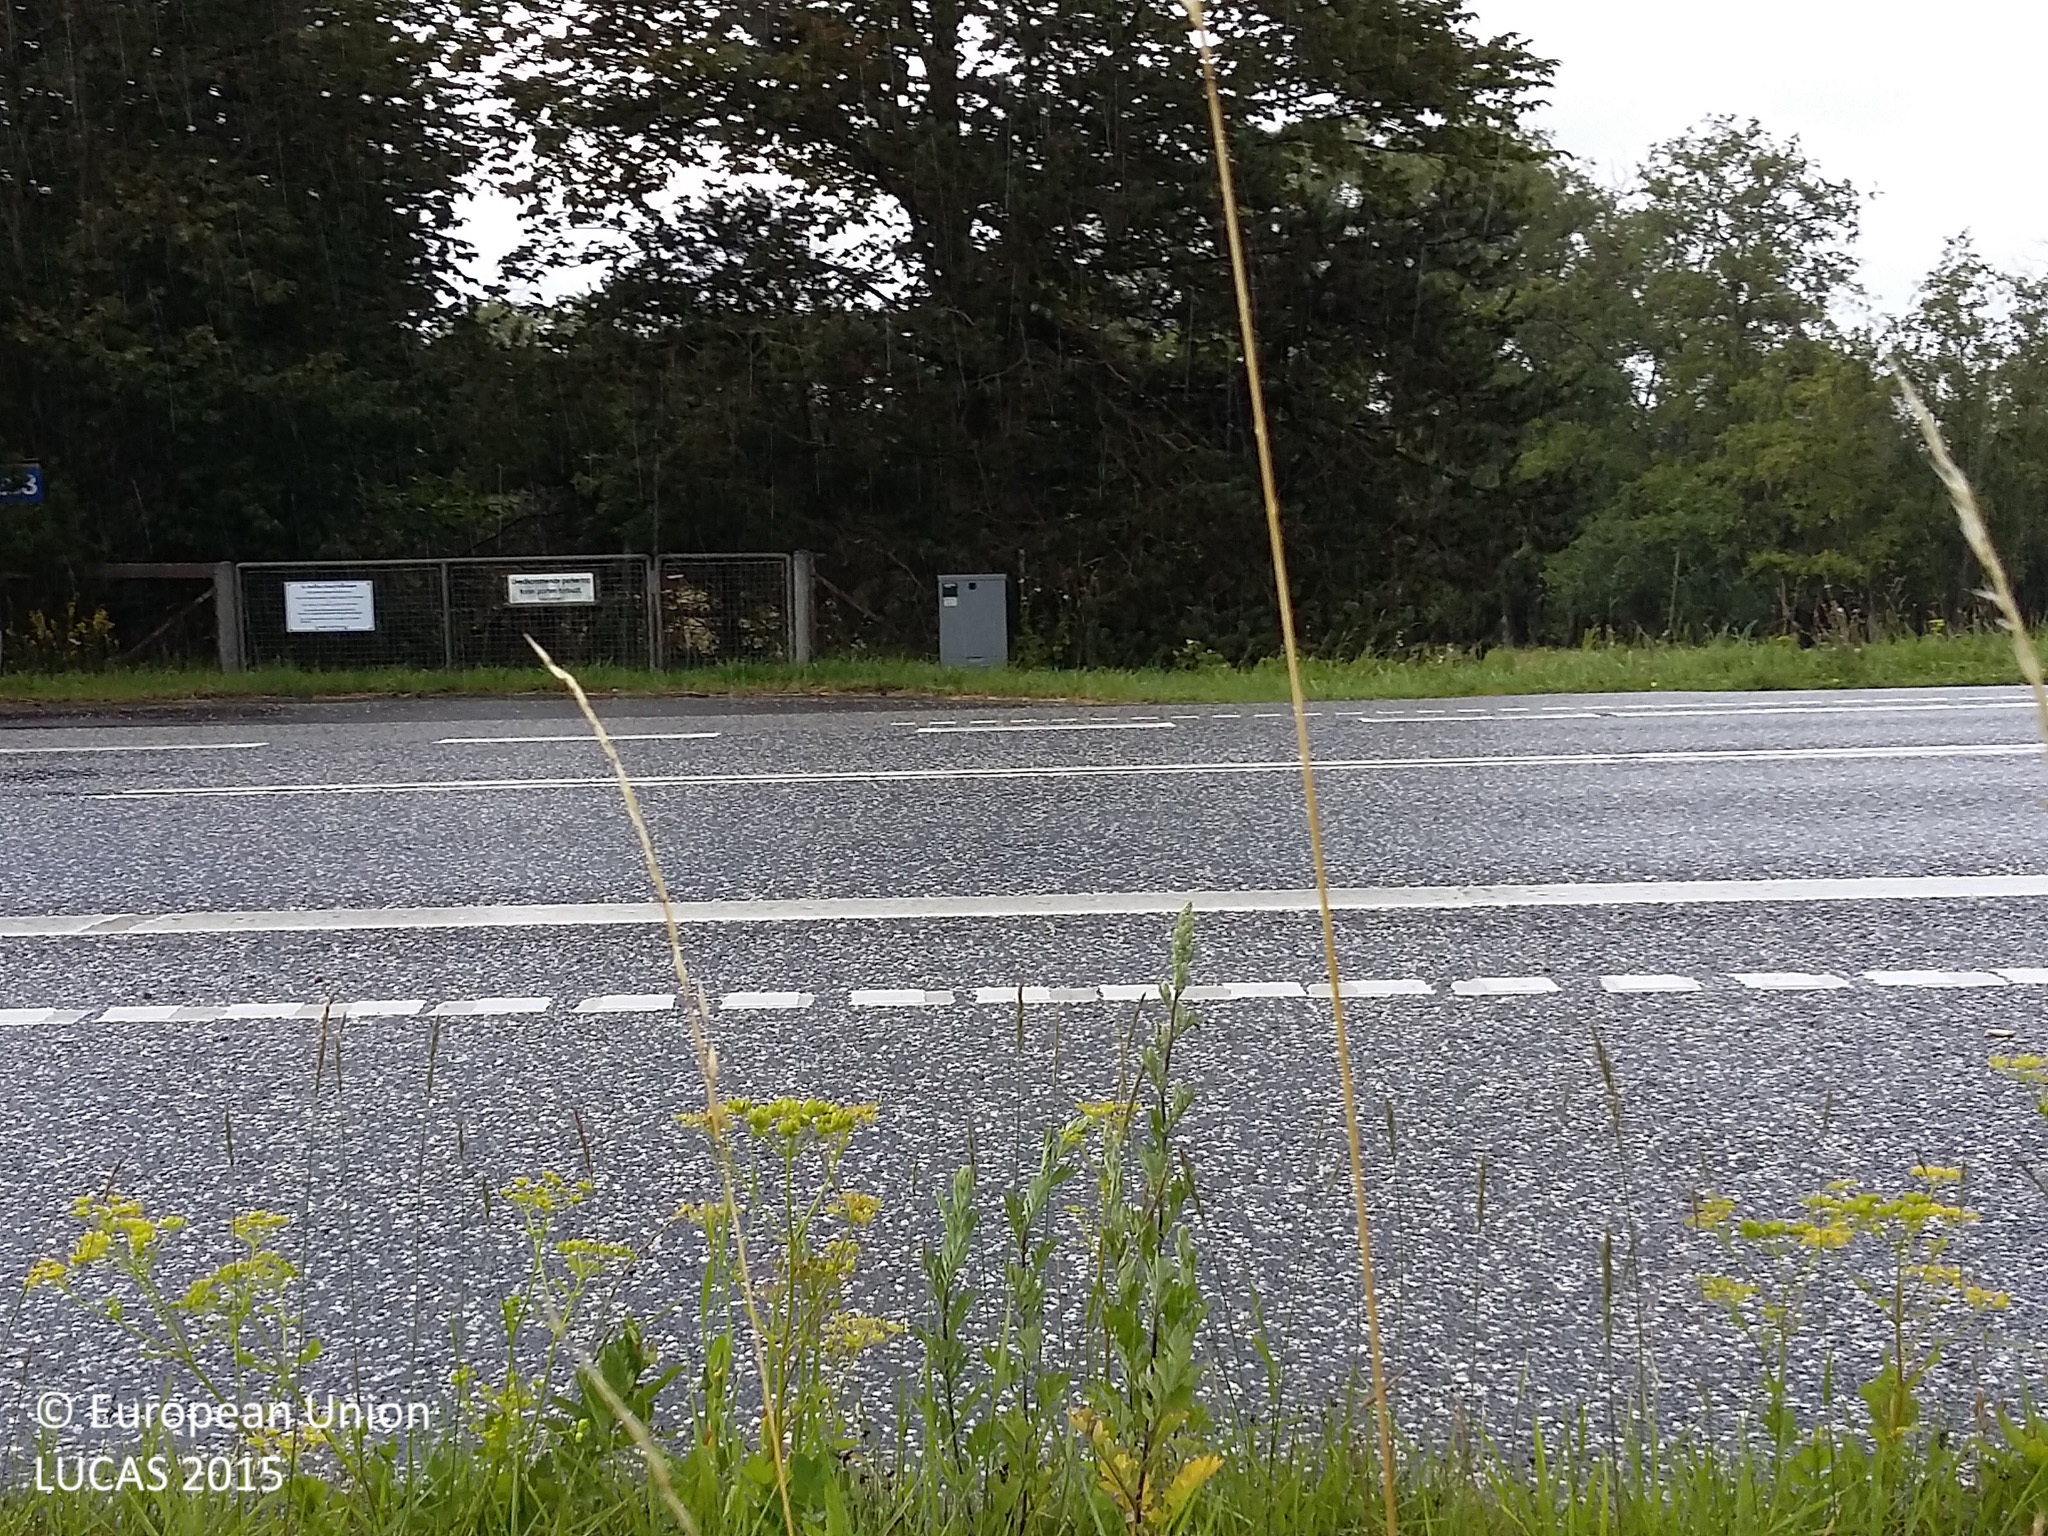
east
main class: Grassland
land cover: Spontaneously vegetated surfaces
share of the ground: > 75 %
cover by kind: herbaceous plants 100 %
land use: Semi-natural and natural areas not in use
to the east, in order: Spontaneously vegetated surfaces; Paved roads, cycling and walking lanes; Grass margins; Pine dominated coniferous woodland; Fences; Grassland without tree/shrub cover; Broadleaved woodland; Inland fresh water bodies; Broadleaved woodland; Grassland without tree/shrub cover; Fences; Barley
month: July
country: DK
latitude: 55.9015
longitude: 12.0613
